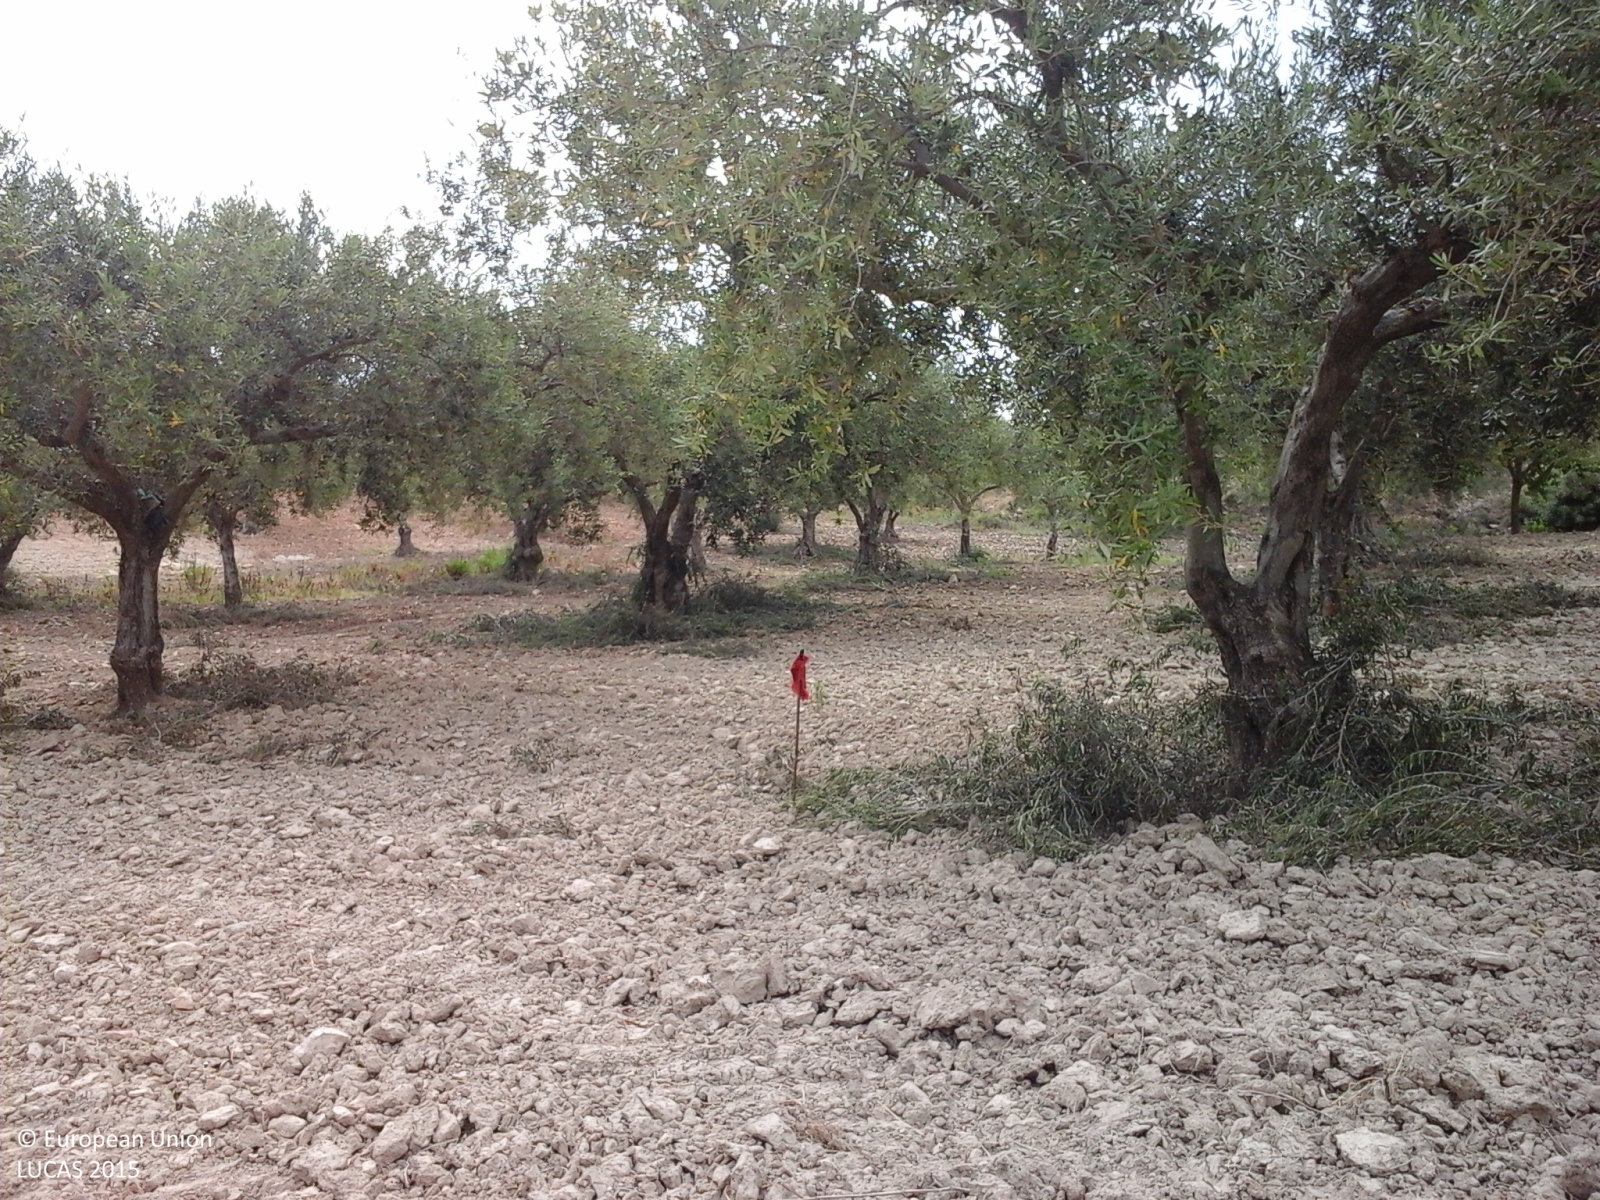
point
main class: Cropland
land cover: Olive groves
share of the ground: 50 - 75 %
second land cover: Other bare soil
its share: > 75 %
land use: Agriculture (excluding fallow land and kitchen gardens)
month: May
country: IT
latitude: 37.5332
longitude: 13.1109
